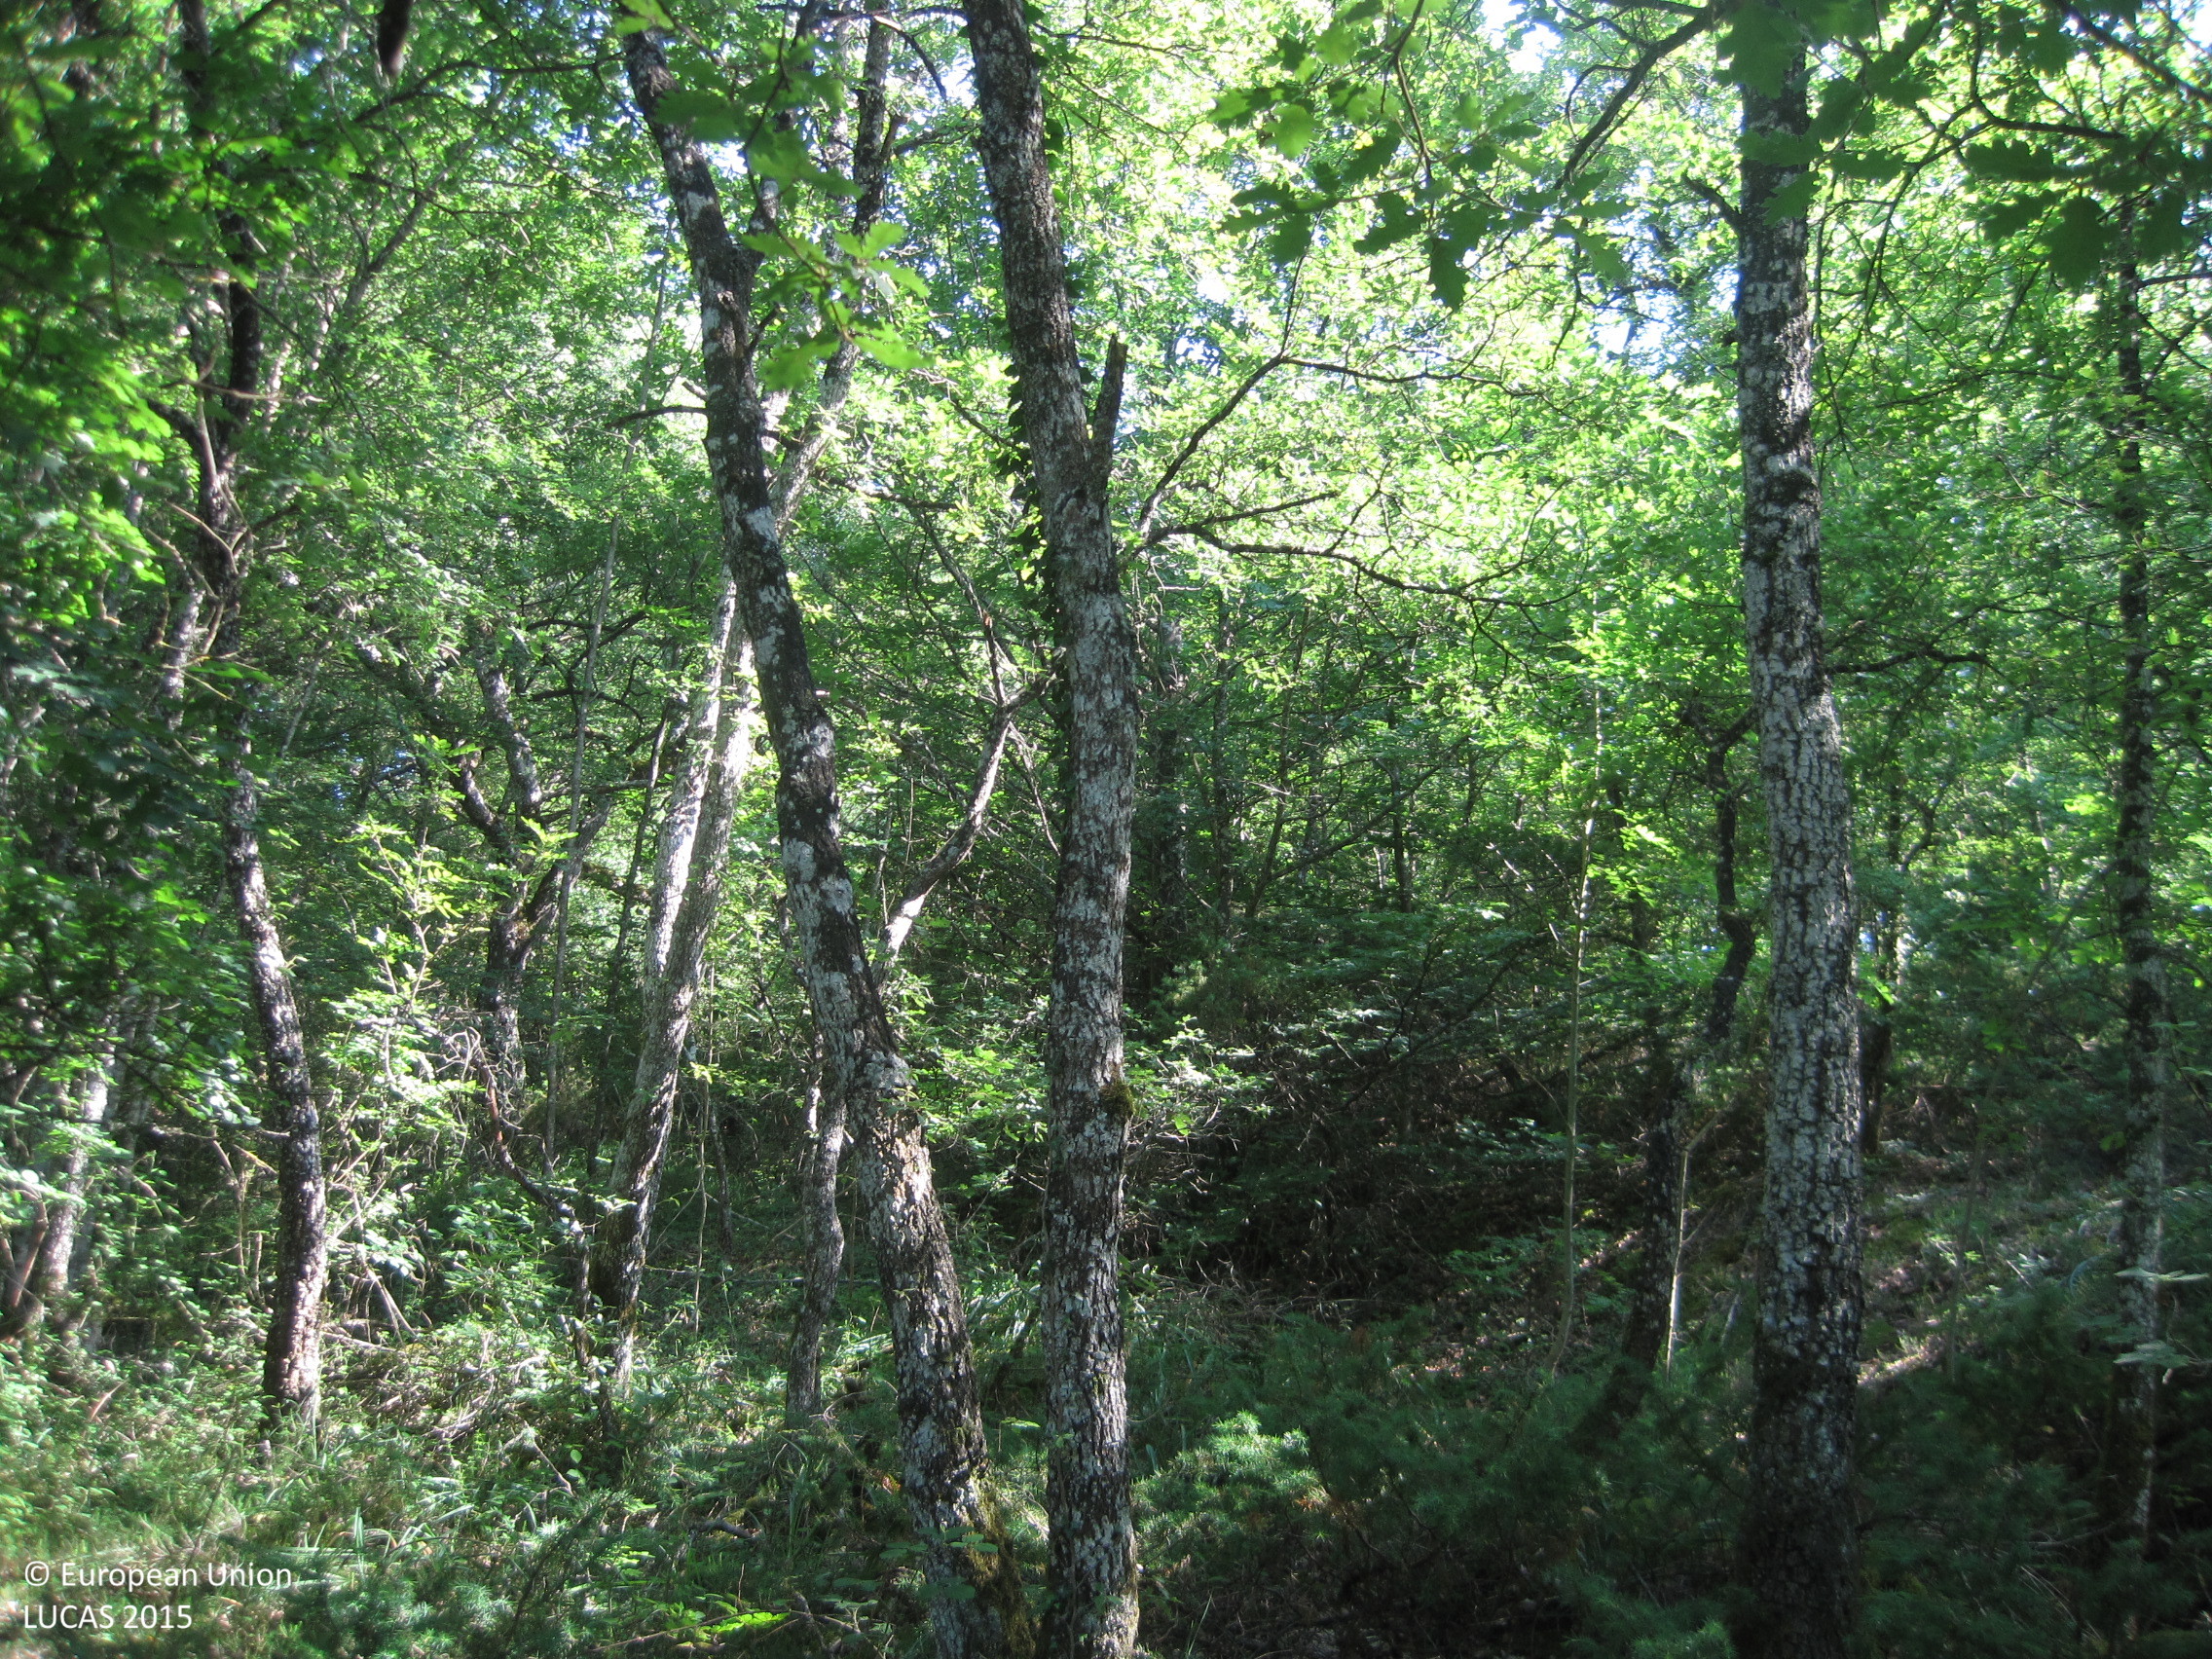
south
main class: Woodland
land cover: Broadleaved woodland
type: acidophilous oak and oak-birch forest
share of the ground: > 75 %
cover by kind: broadleaved forest trees 100 %
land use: Forestry
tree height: > 5 m
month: June
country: ES
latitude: 42.9316
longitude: -1.7677
